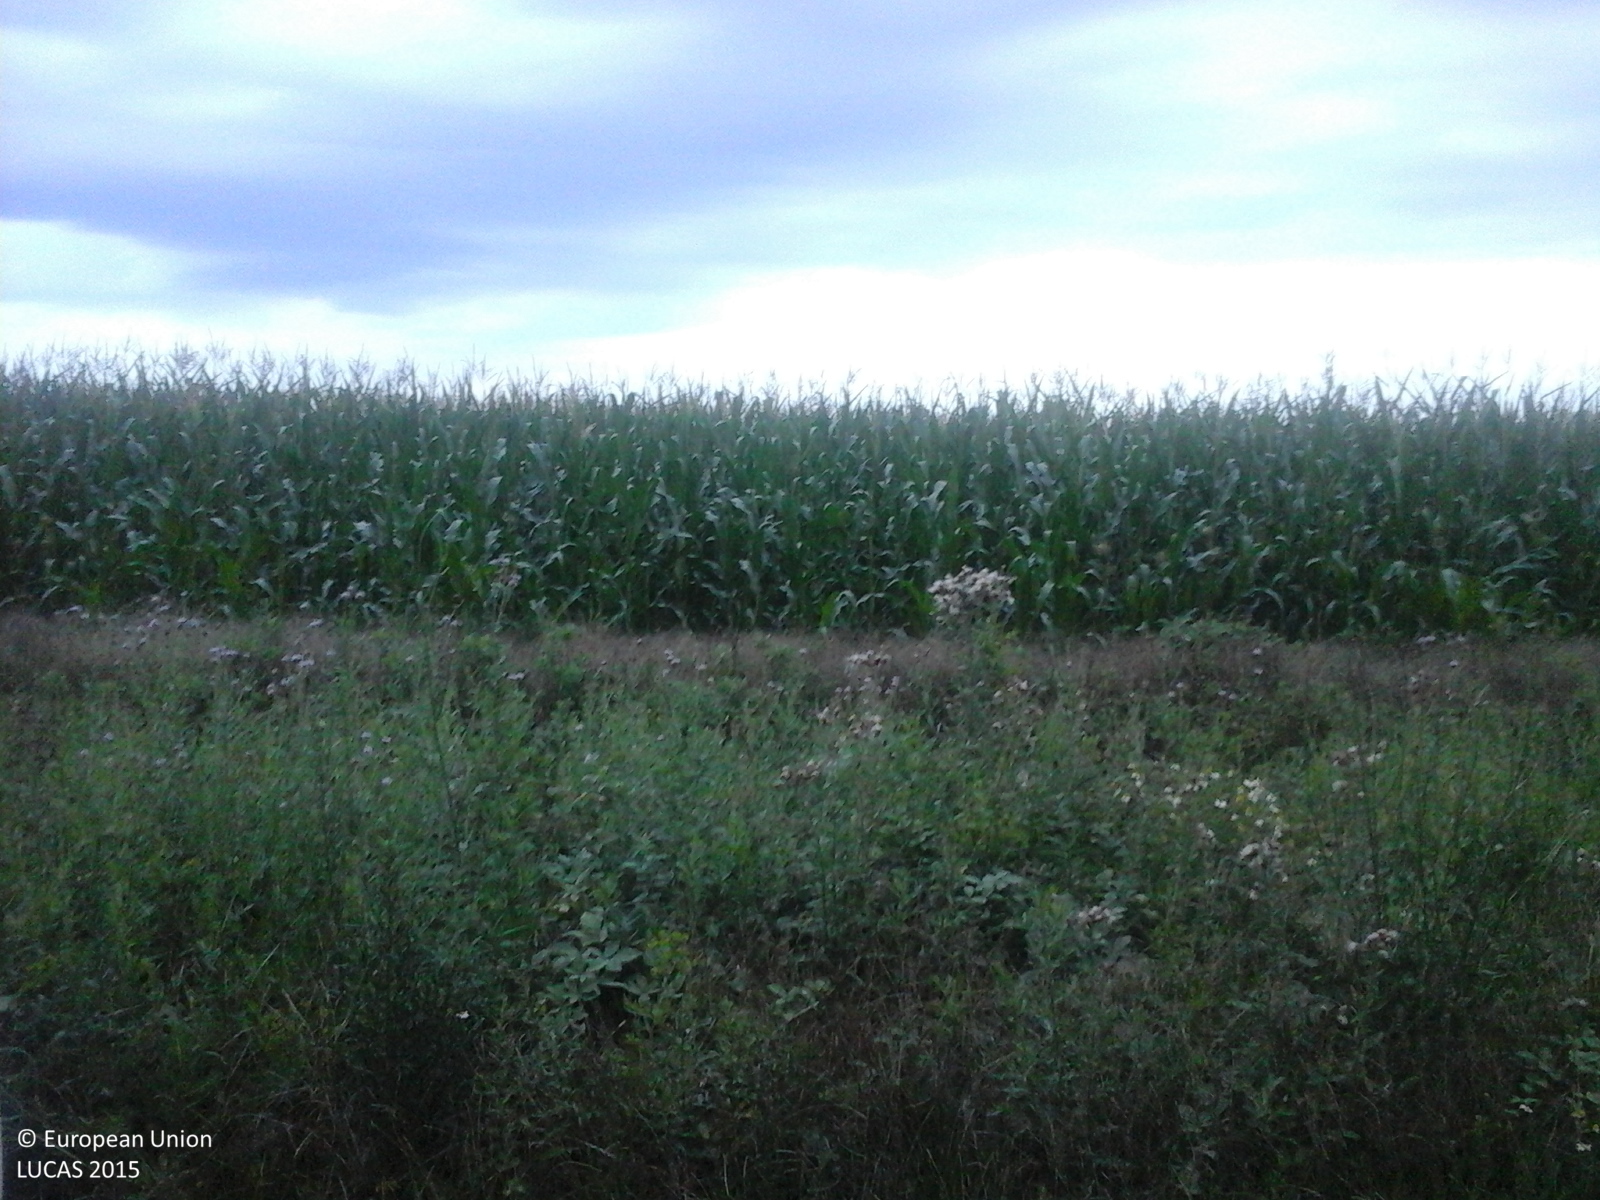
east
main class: Cropland
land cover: Maize
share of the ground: > 75 %
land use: Agriculture (excluding fallow land and kitchen gardens)
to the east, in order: Maize
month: July
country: RO
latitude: 44.0767
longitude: 24.2350
